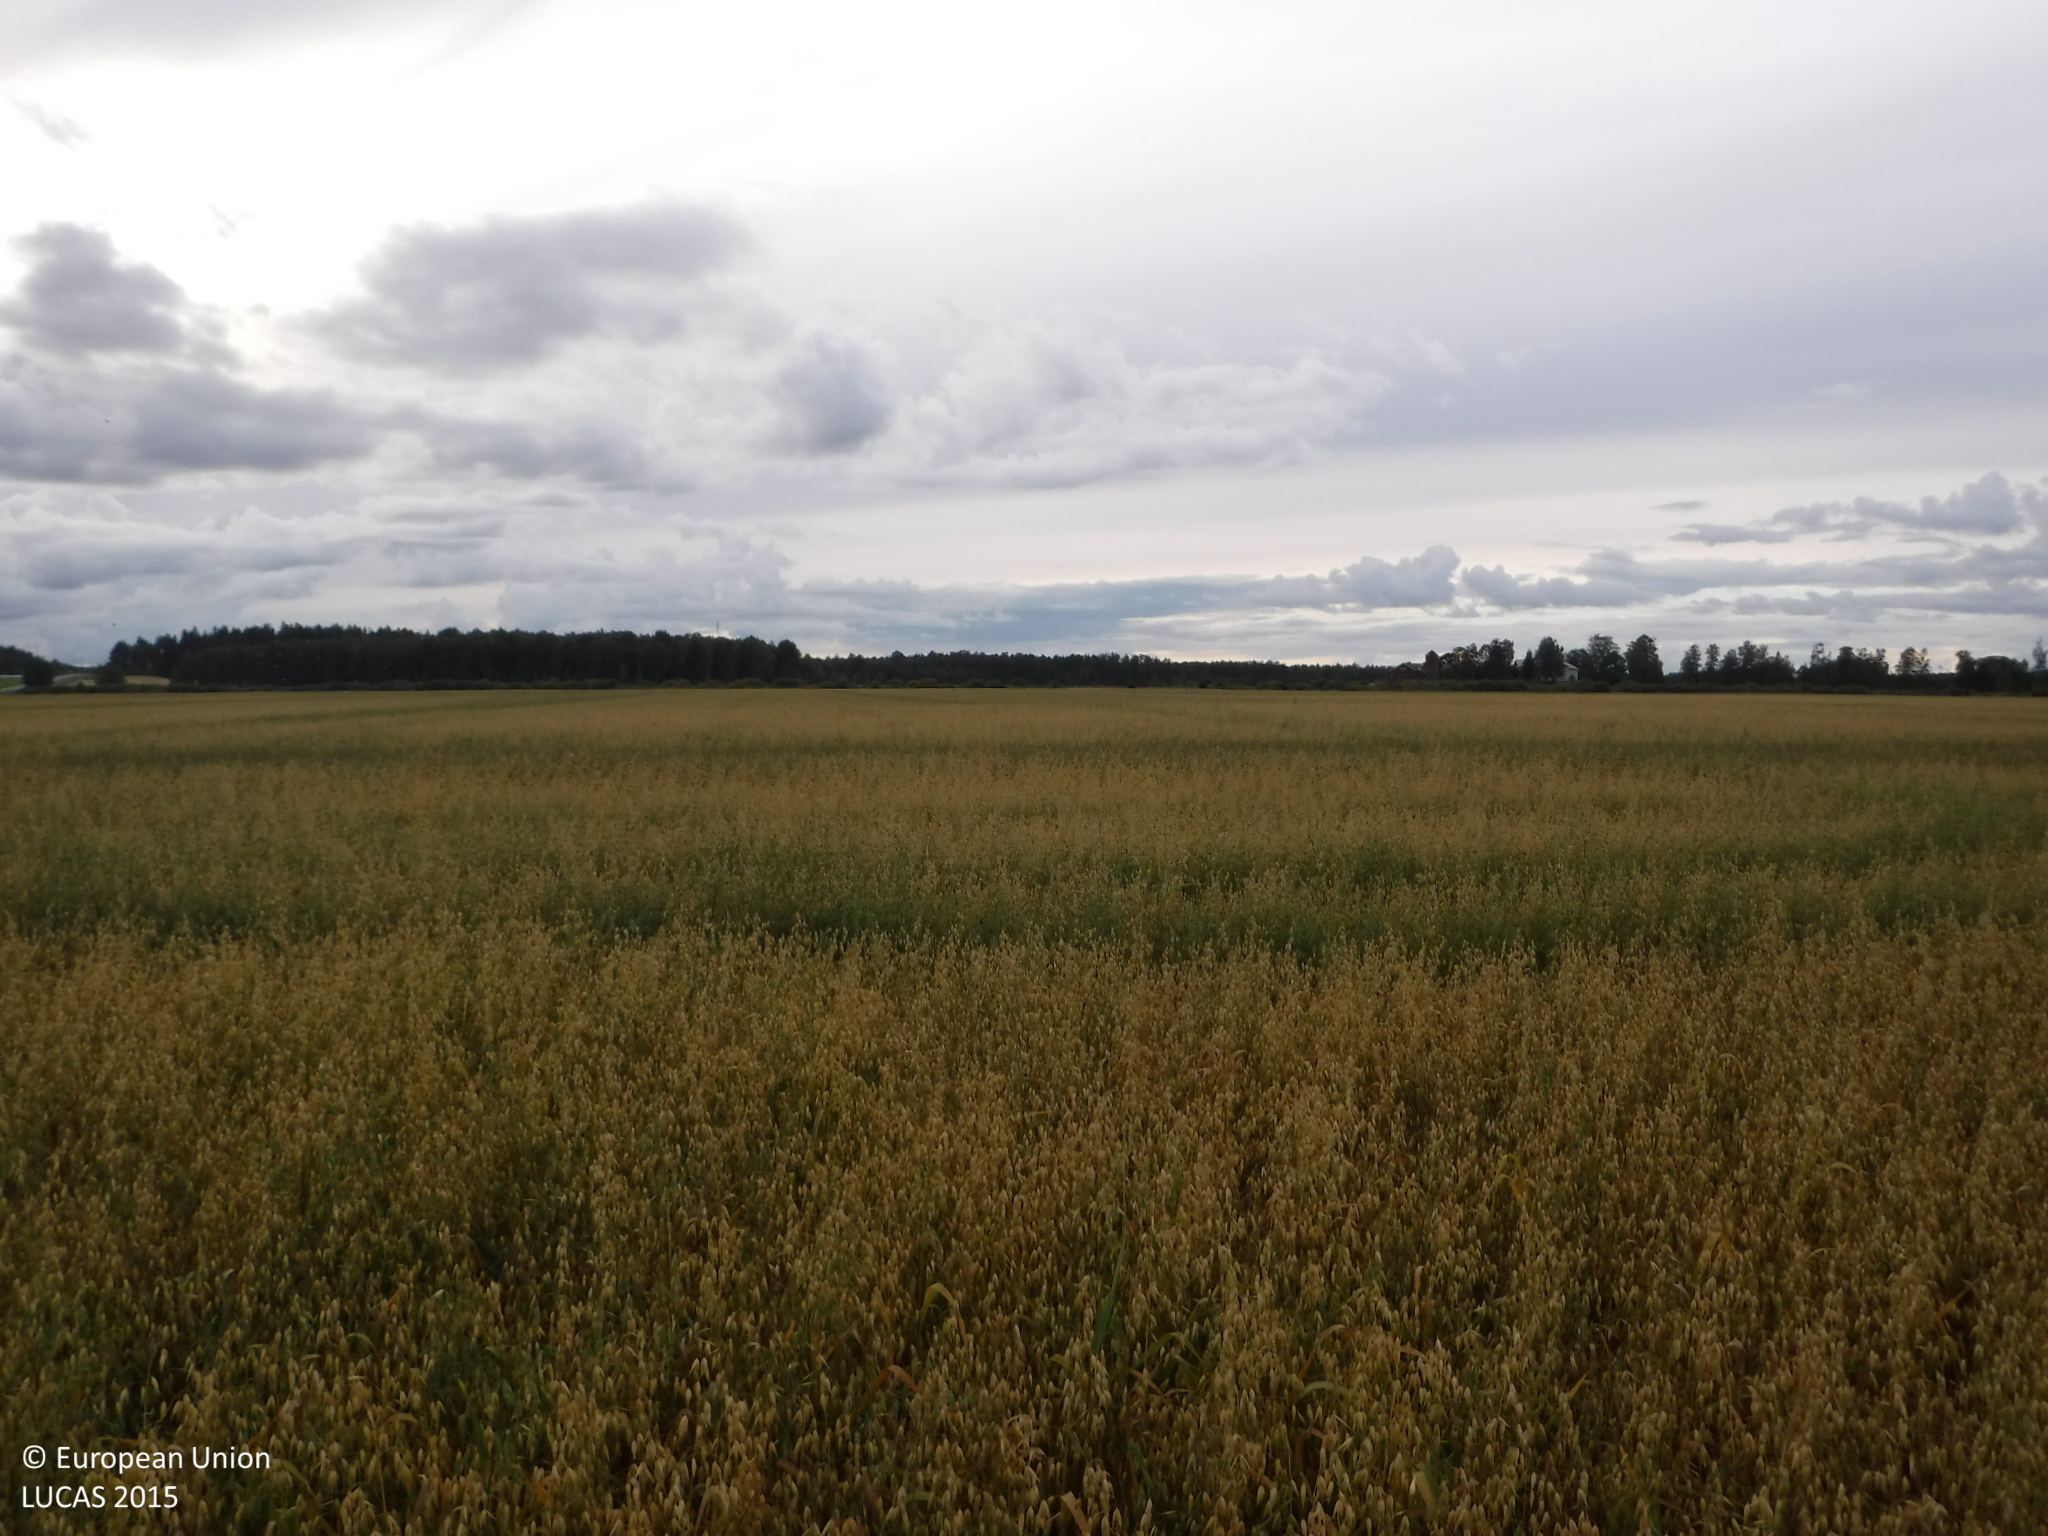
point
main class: Cropland
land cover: Oats
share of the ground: > 75 %
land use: Agriculture (excluding fallow land and kitchen gardens)
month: September
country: FI
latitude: 61.3220
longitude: 22.9041
